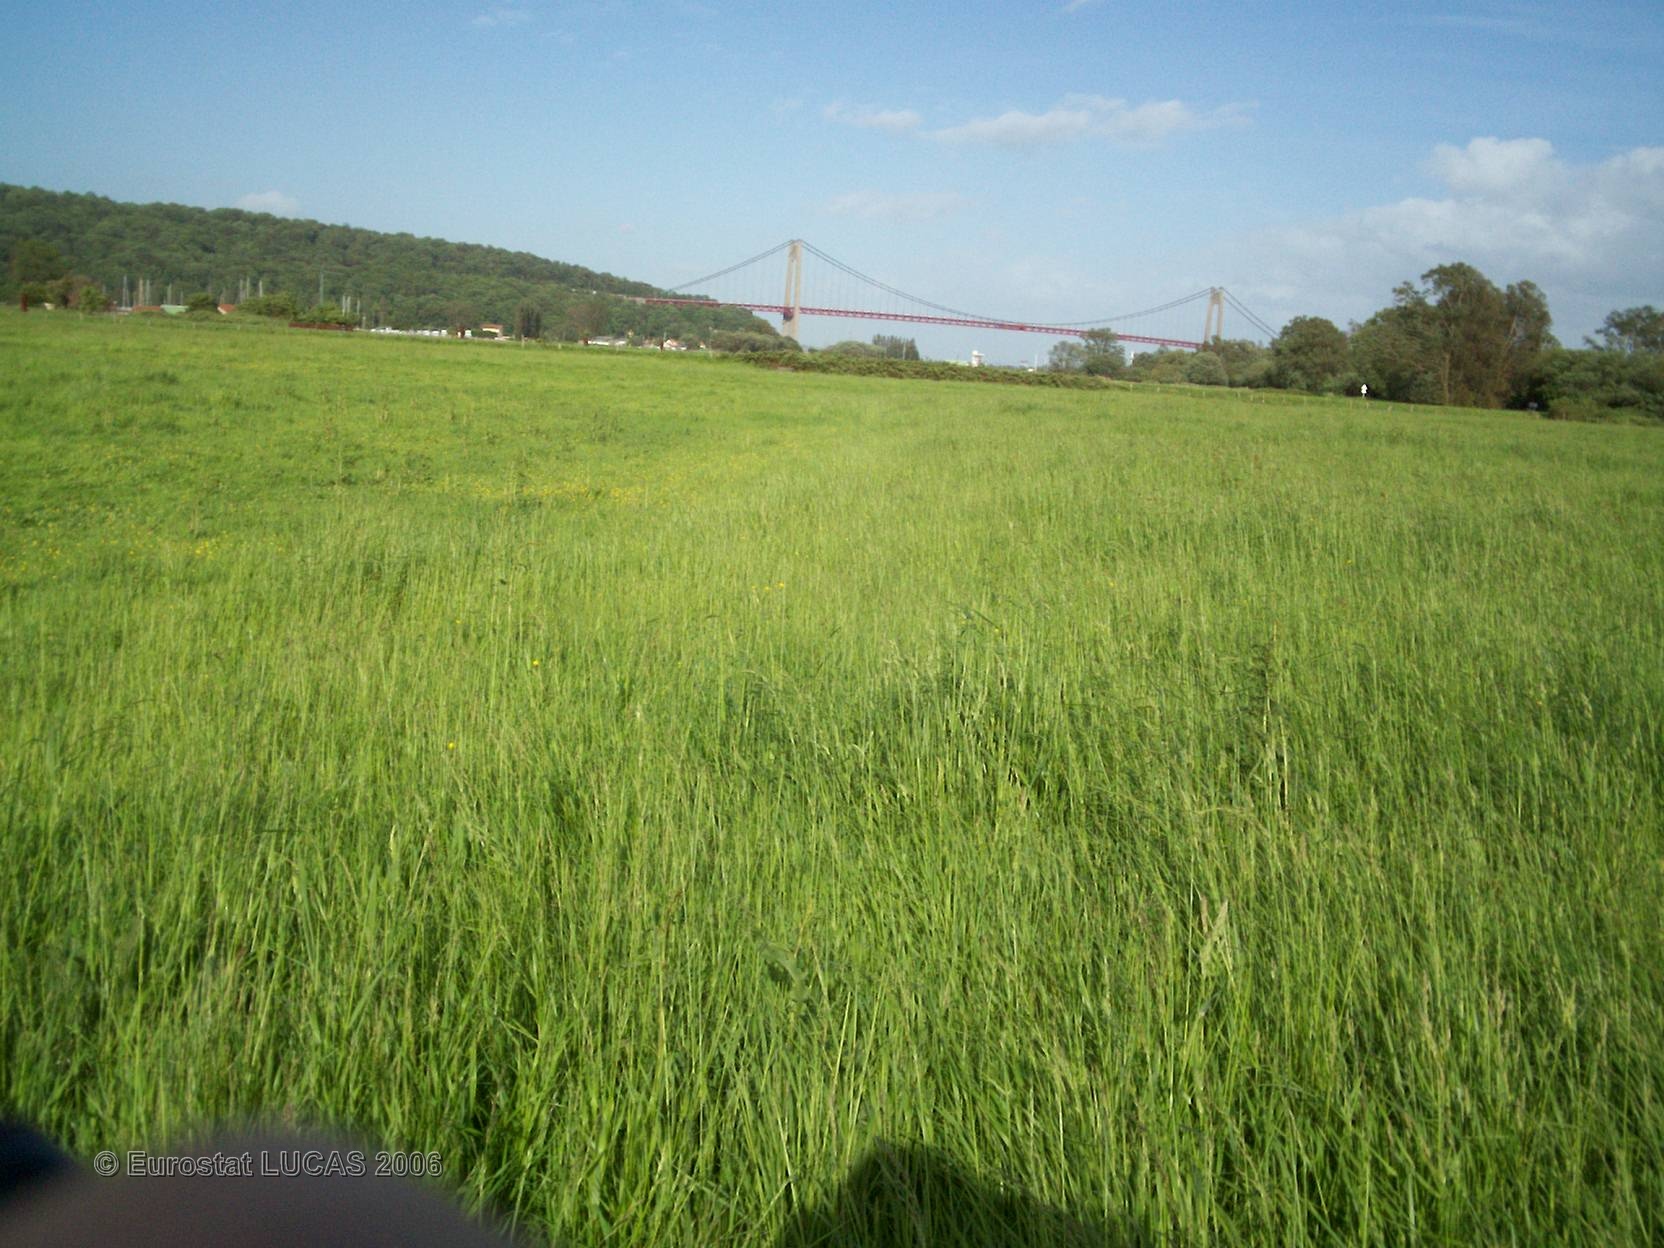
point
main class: Grassland
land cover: Grassland without tree/shrub cover
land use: Agriculture (excluding fallow land and kitchen gardens)
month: May
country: FR
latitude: 49.4735
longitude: 0.4366
